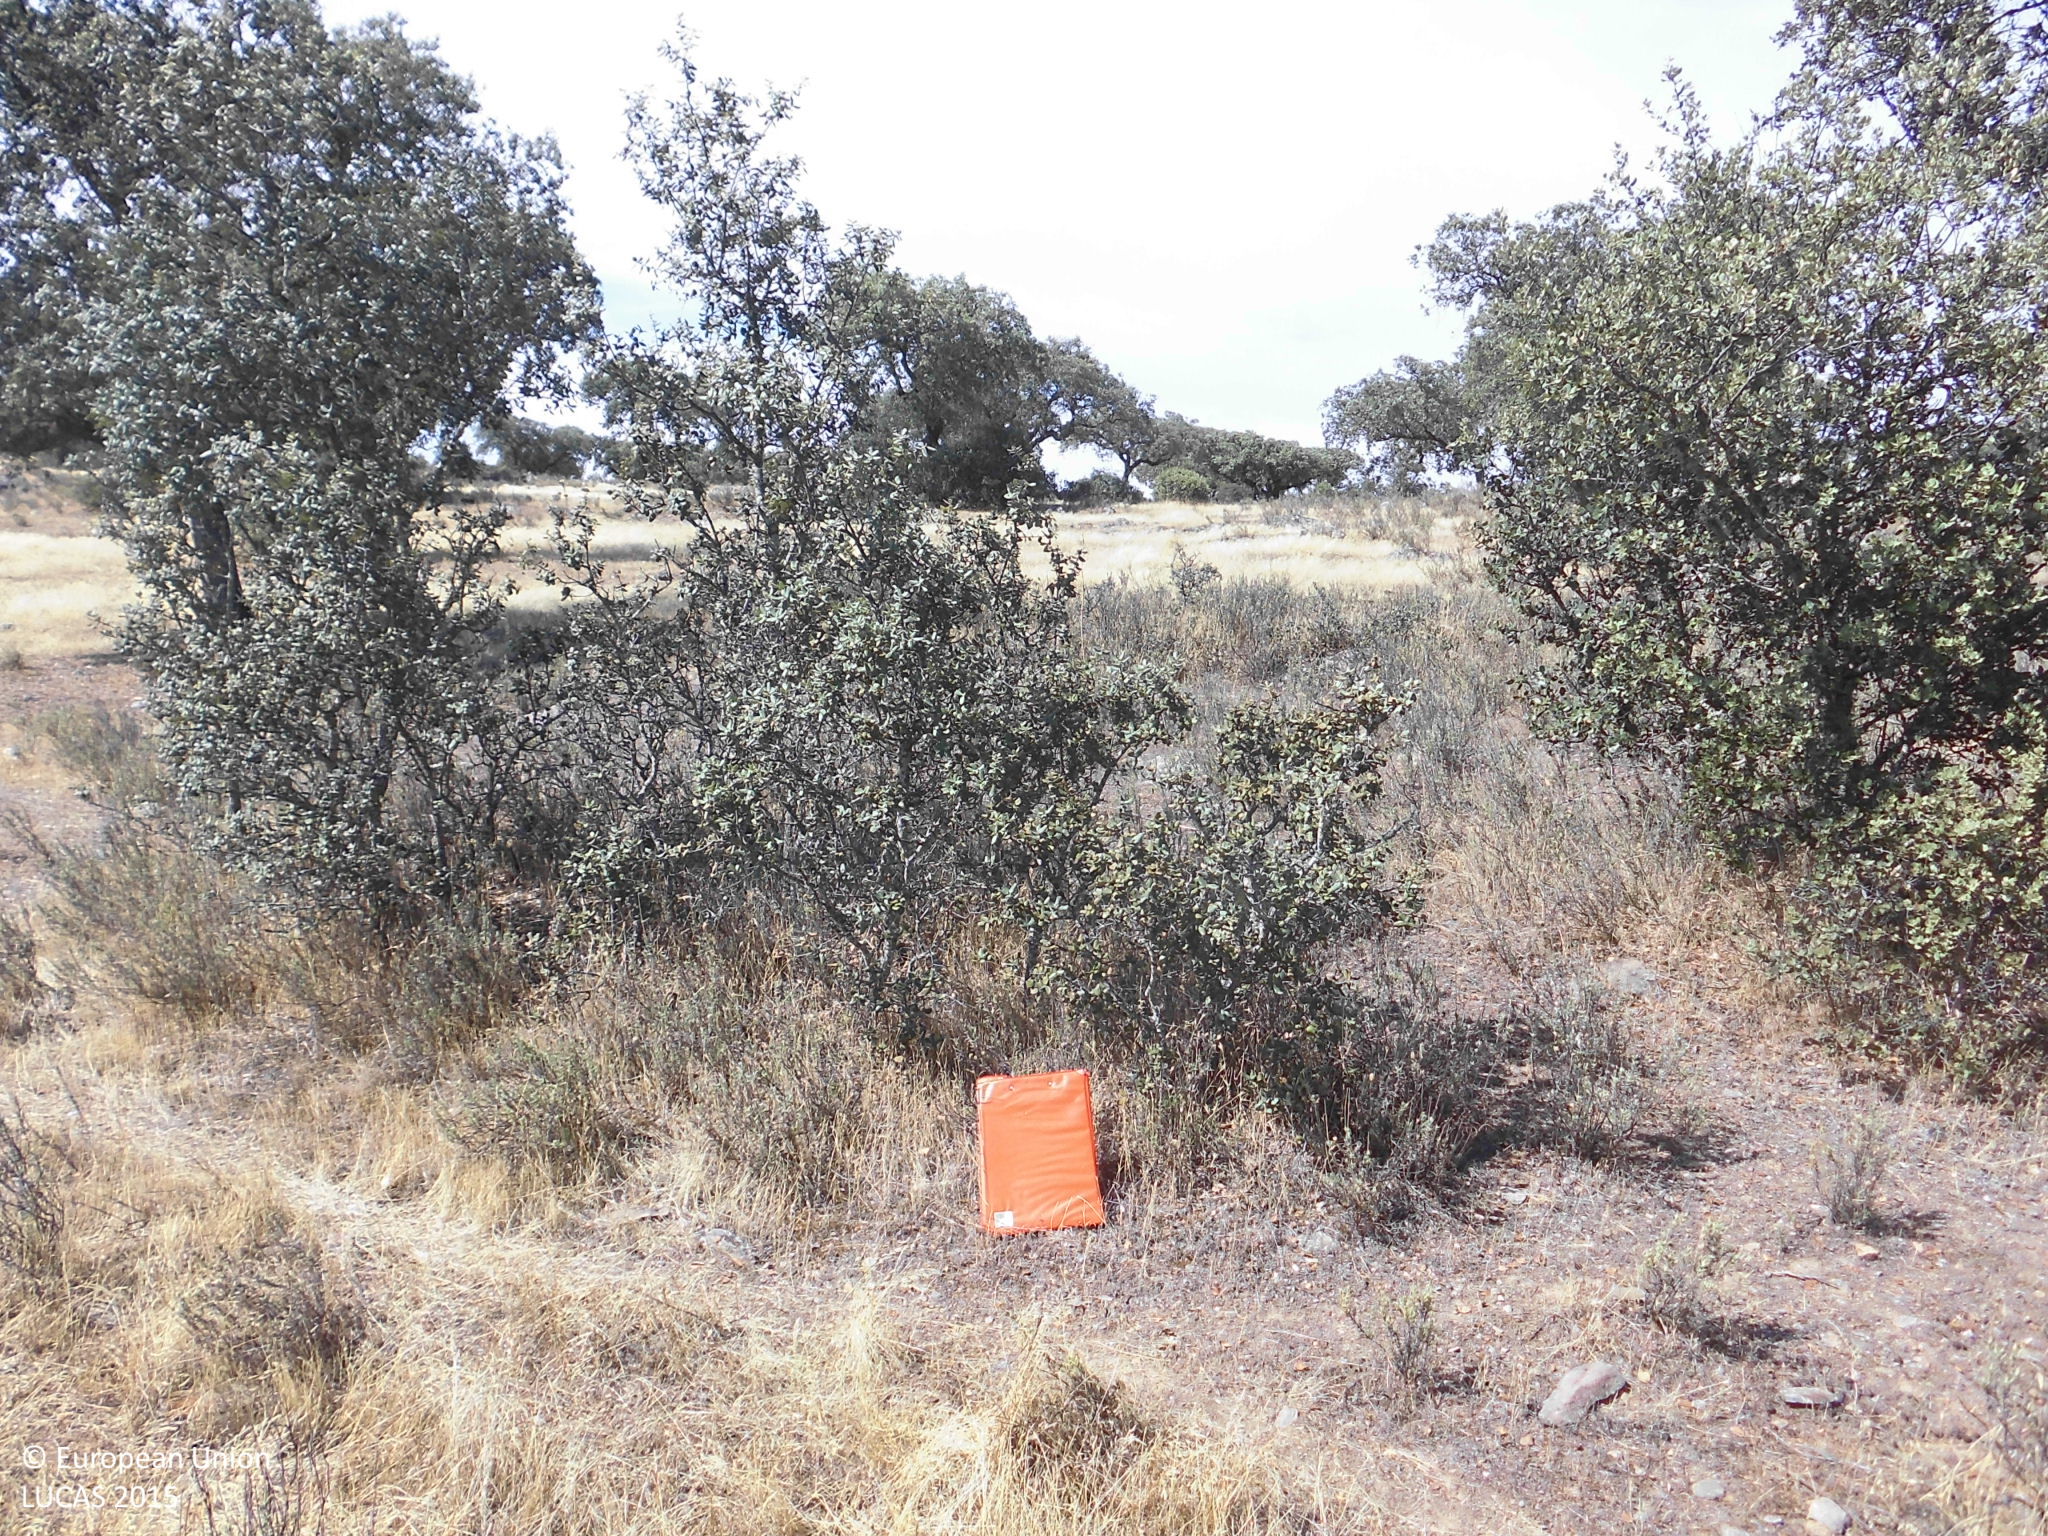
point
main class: Woodland
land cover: Broadleaved woodland
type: broadleaved evergreen forest
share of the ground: 10 - 25 %
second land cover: Grassland without tree/shrub cover
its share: > 75 %
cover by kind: herbaceous plants 65 %, shrubs 20 %, broadleaved forest trees 15 %
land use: Forestry
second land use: Agriculture (excluding fallow land and kitchen gardens)
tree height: > 5 m
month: June
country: ES
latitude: 39.7573
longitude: -6.0929
